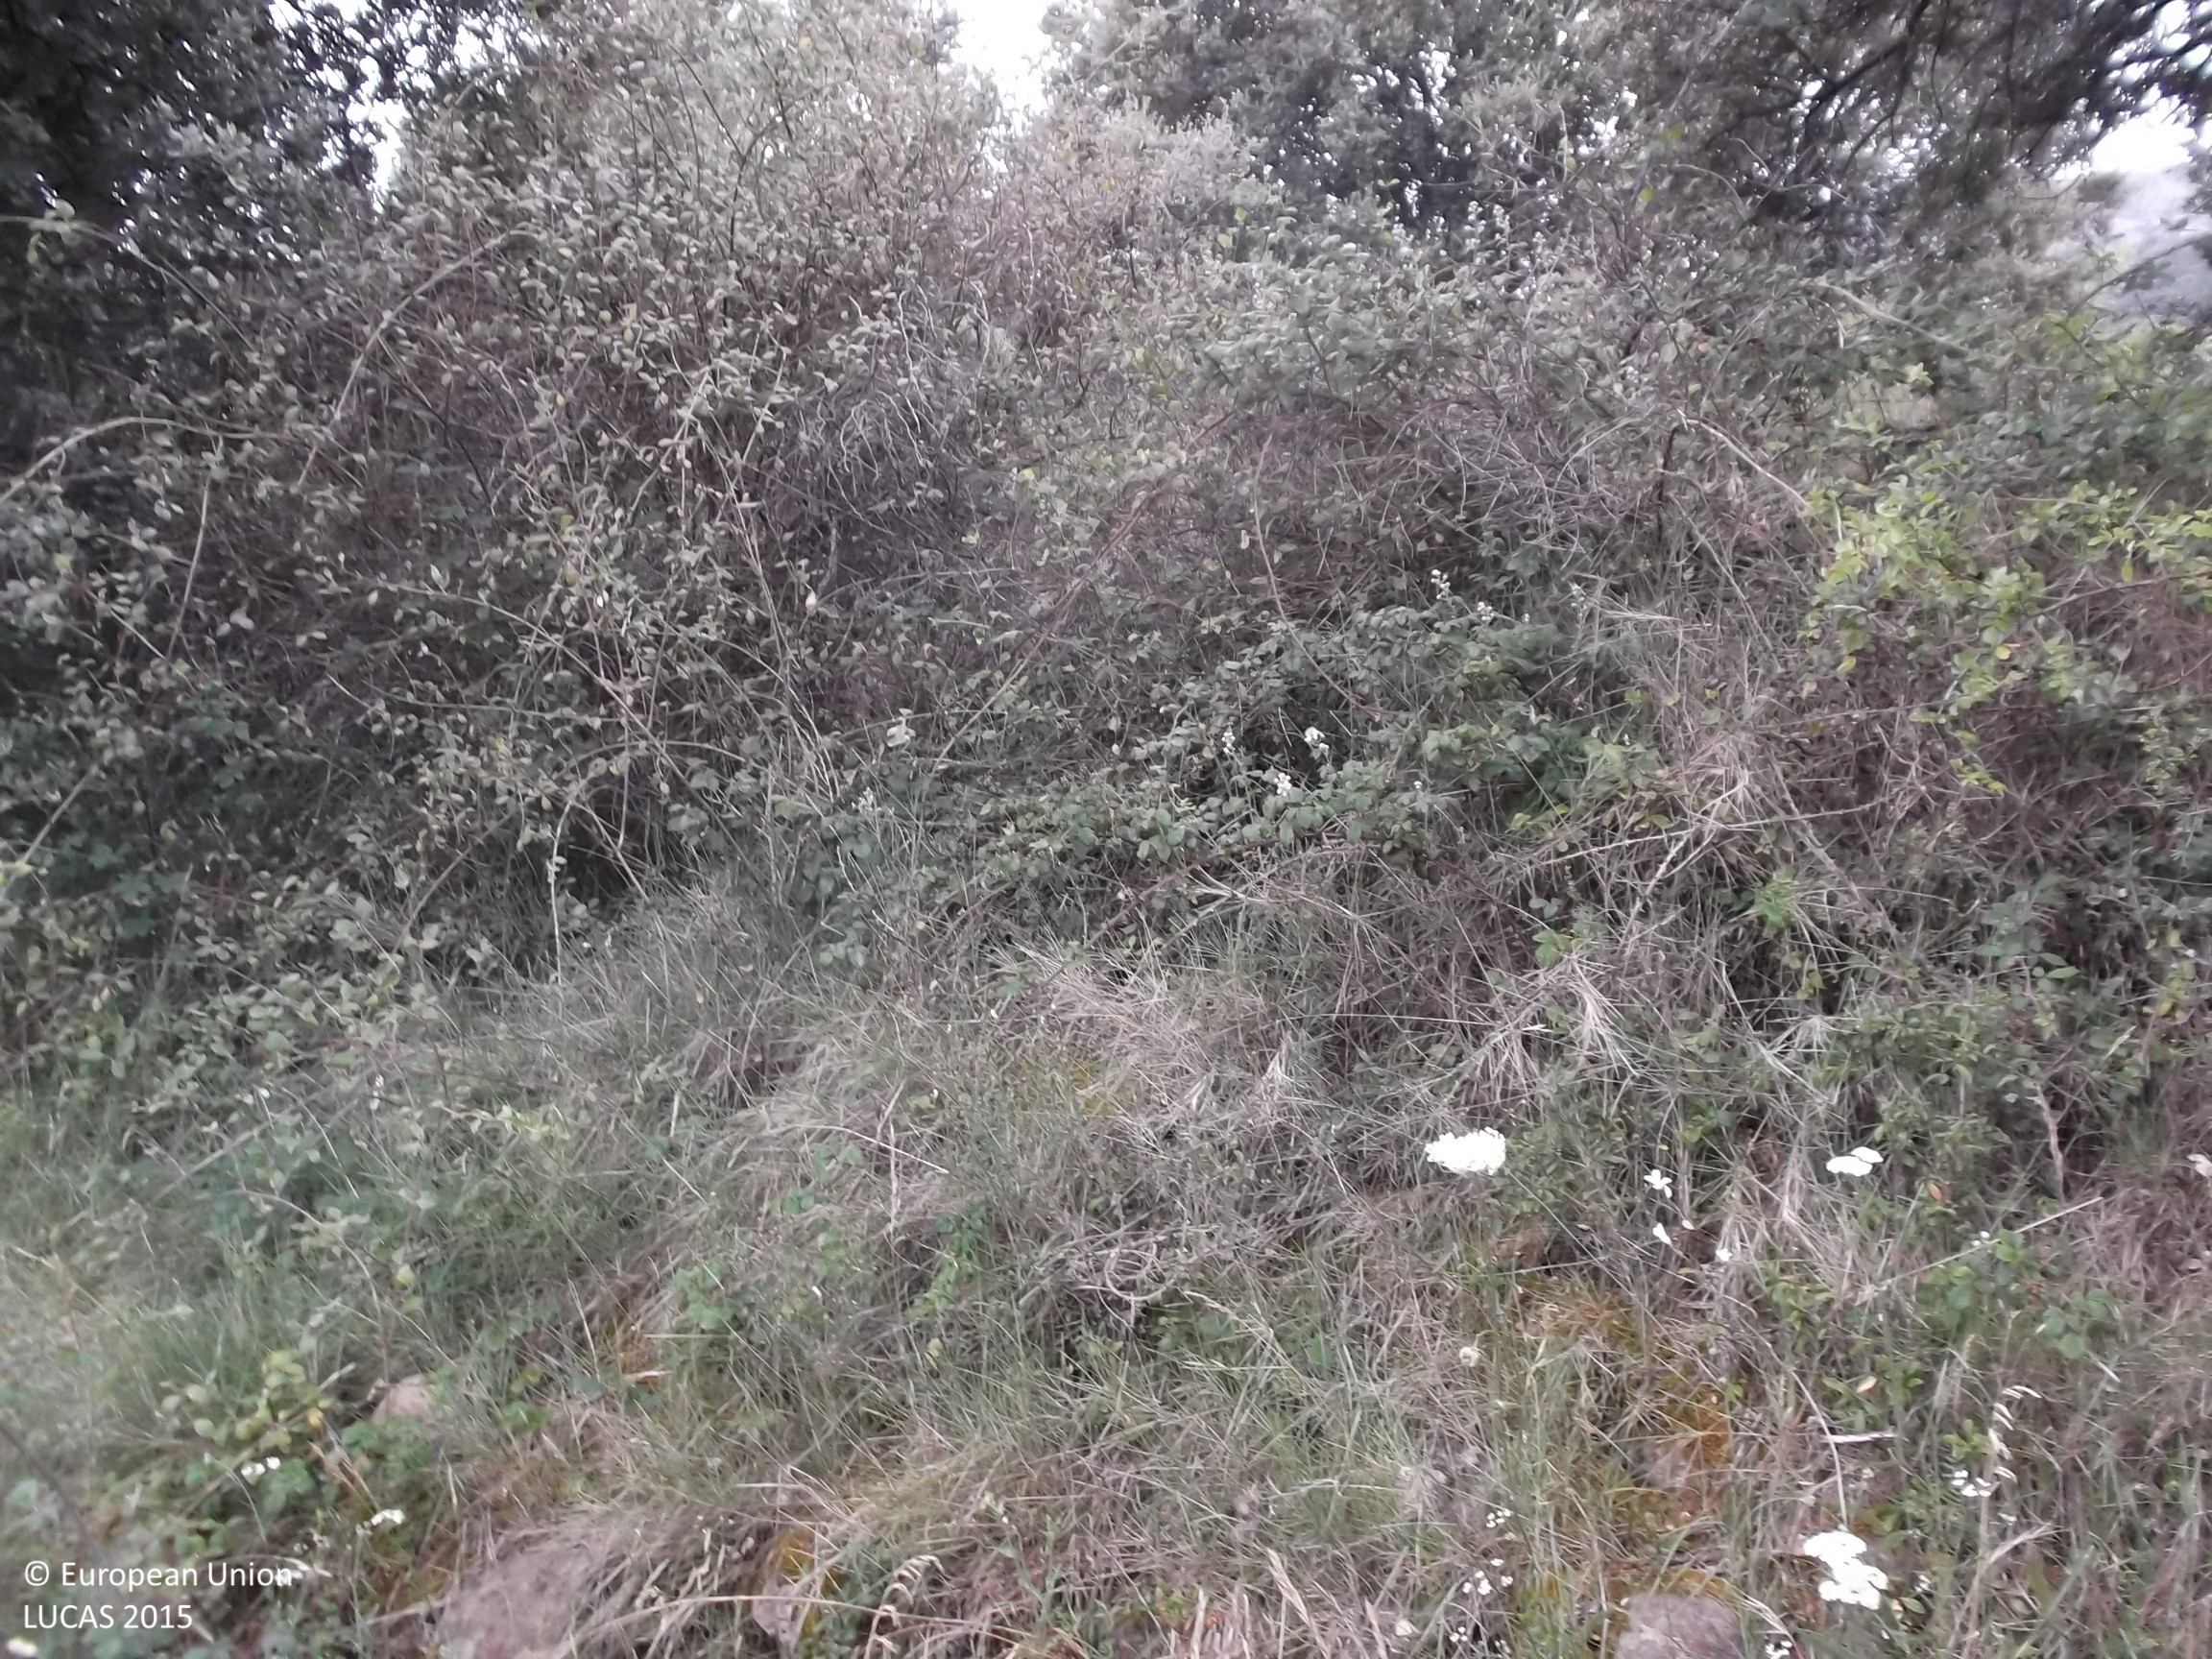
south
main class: Woodland
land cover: Broadleaved woodland
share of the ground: 10 - 25 %
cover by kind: unconsolidated bare surface 40 %, shrubs 30 %, broadleaved forest trees 20 %, herbaceous plants 10 %
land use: Semi-natural and natural areas not in use
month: July
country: ES
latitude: 42.1772
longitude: -2.1327
